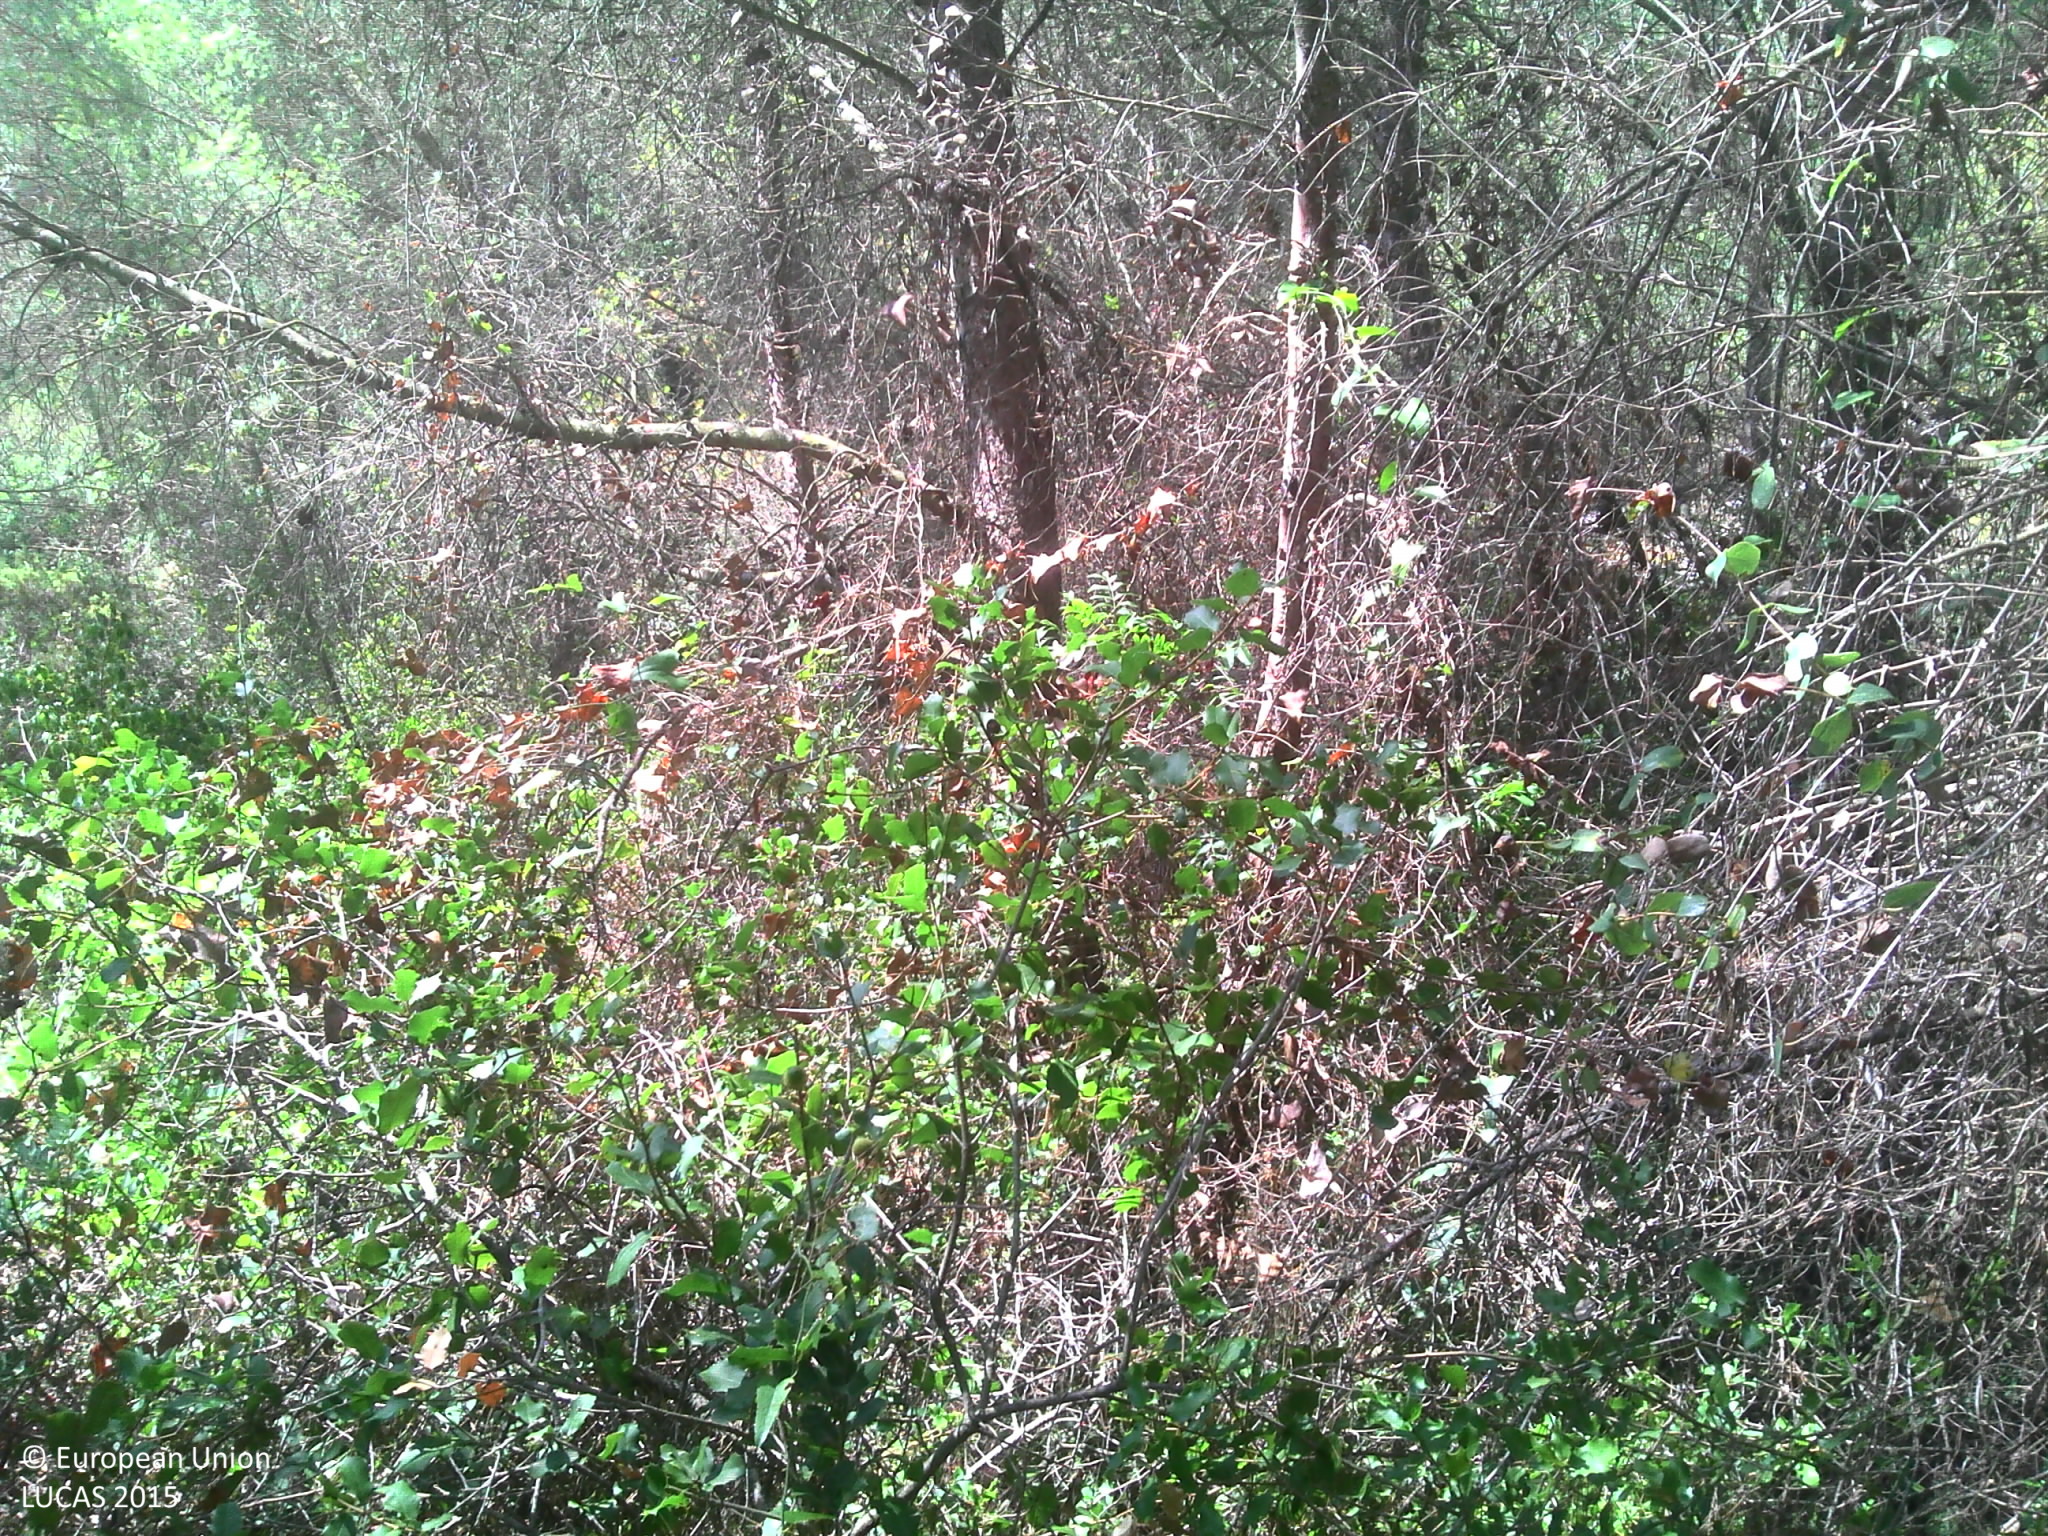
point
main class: Woodland
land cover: Pine dominated coniferous woodland
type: coniferous forest of the mediterranean region
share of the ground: > 75 %
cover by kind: coniferous forest trees 80 %, broadleaved forest trees 20 %
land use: Forestry
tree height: < 5 m
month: August
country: FR
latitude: 43.2090
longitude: 5.5917
